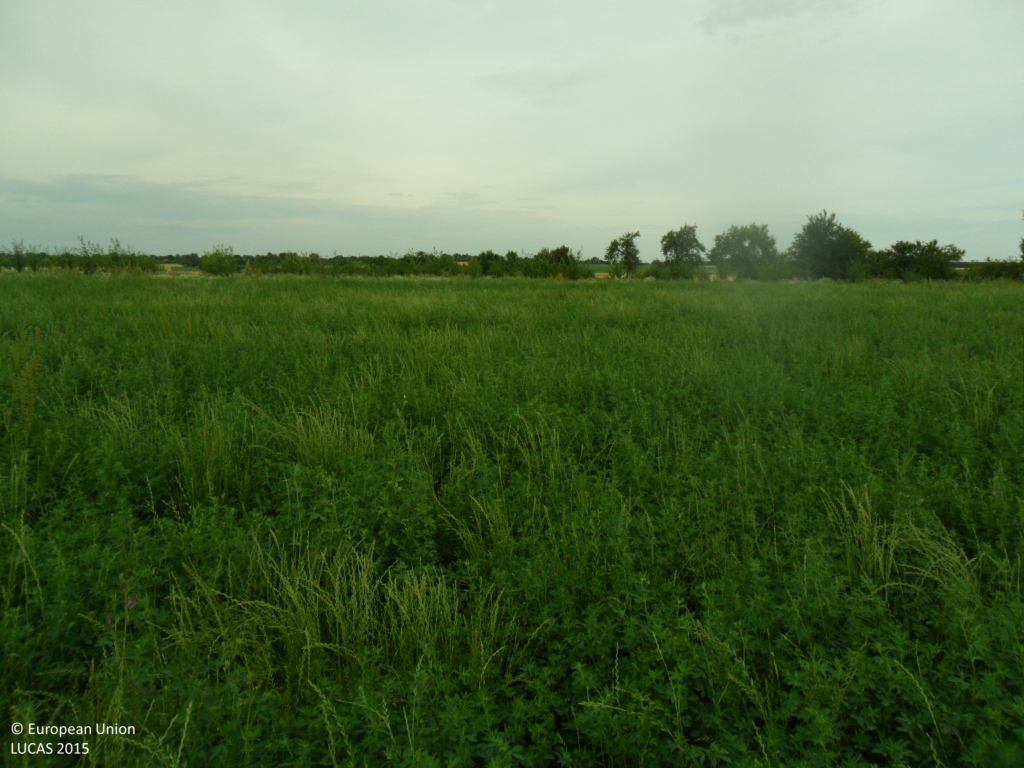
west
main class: Cropland
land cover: Lucerne
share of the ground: > 75 %
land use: Agriculture (excluding fallow land and kitchen gardens)
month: June
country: BG
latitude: 43.7011
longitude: 26.9319
